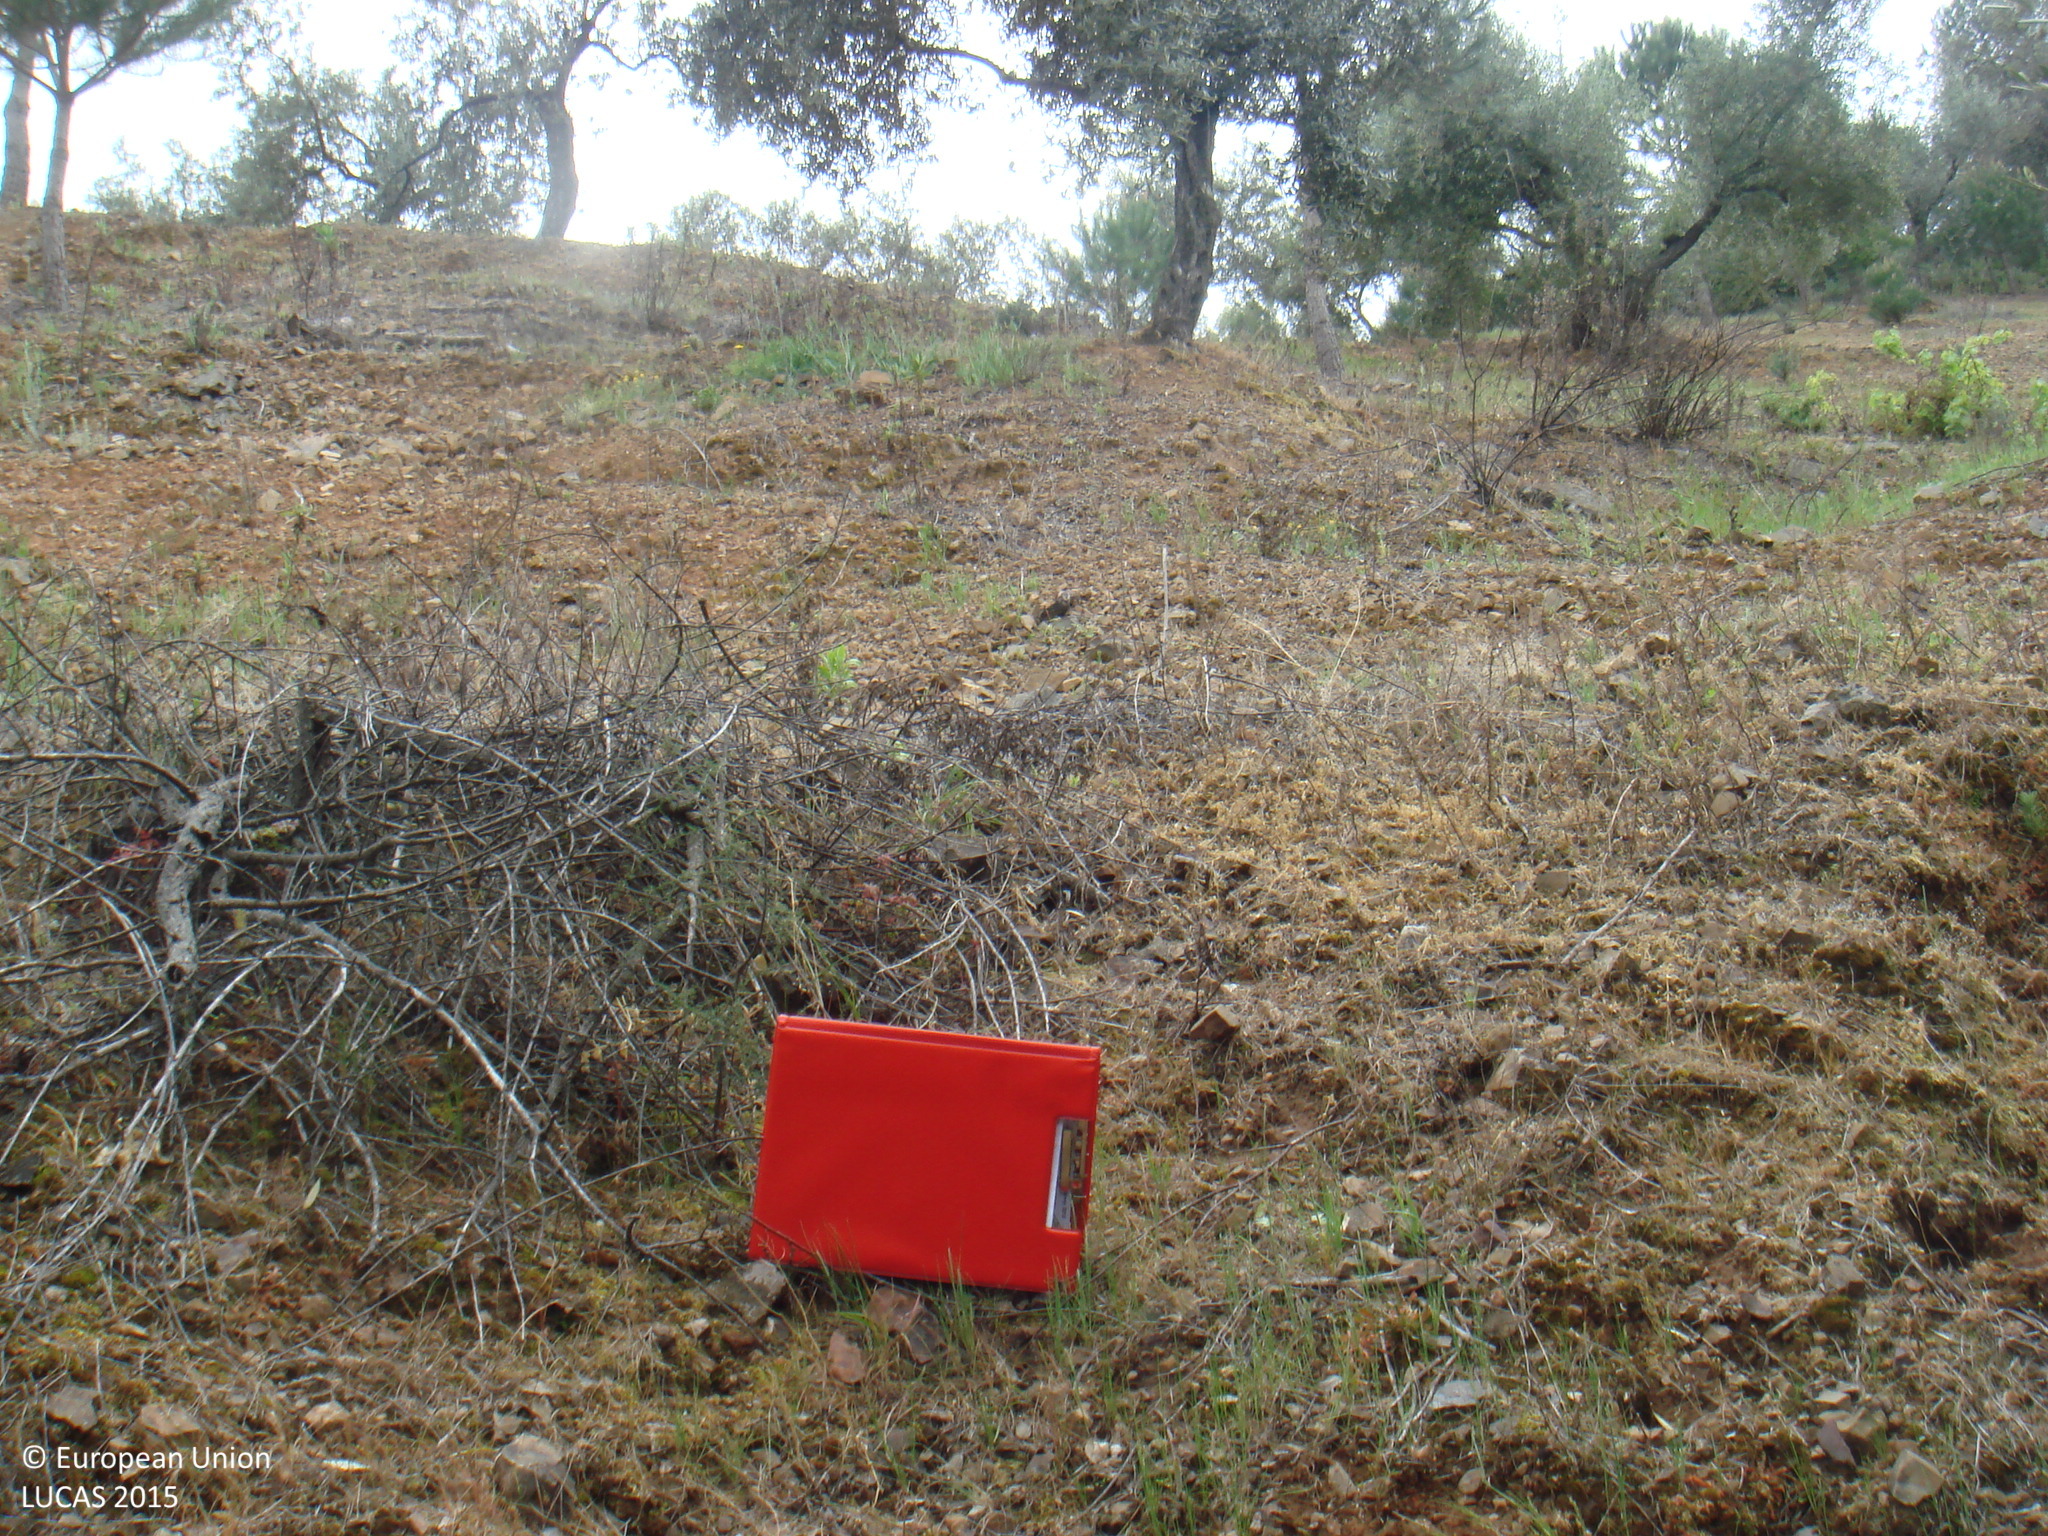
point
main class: Cropland
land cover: Olive groves
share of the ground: 10 - 25 %
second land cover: Spontaneously vegetated surfaces
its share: 50 - 75 %
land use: Agriculture (excluding fallow land and kitchen gardens)
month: April
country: ES
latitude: 38.0580
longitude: -5.0075
